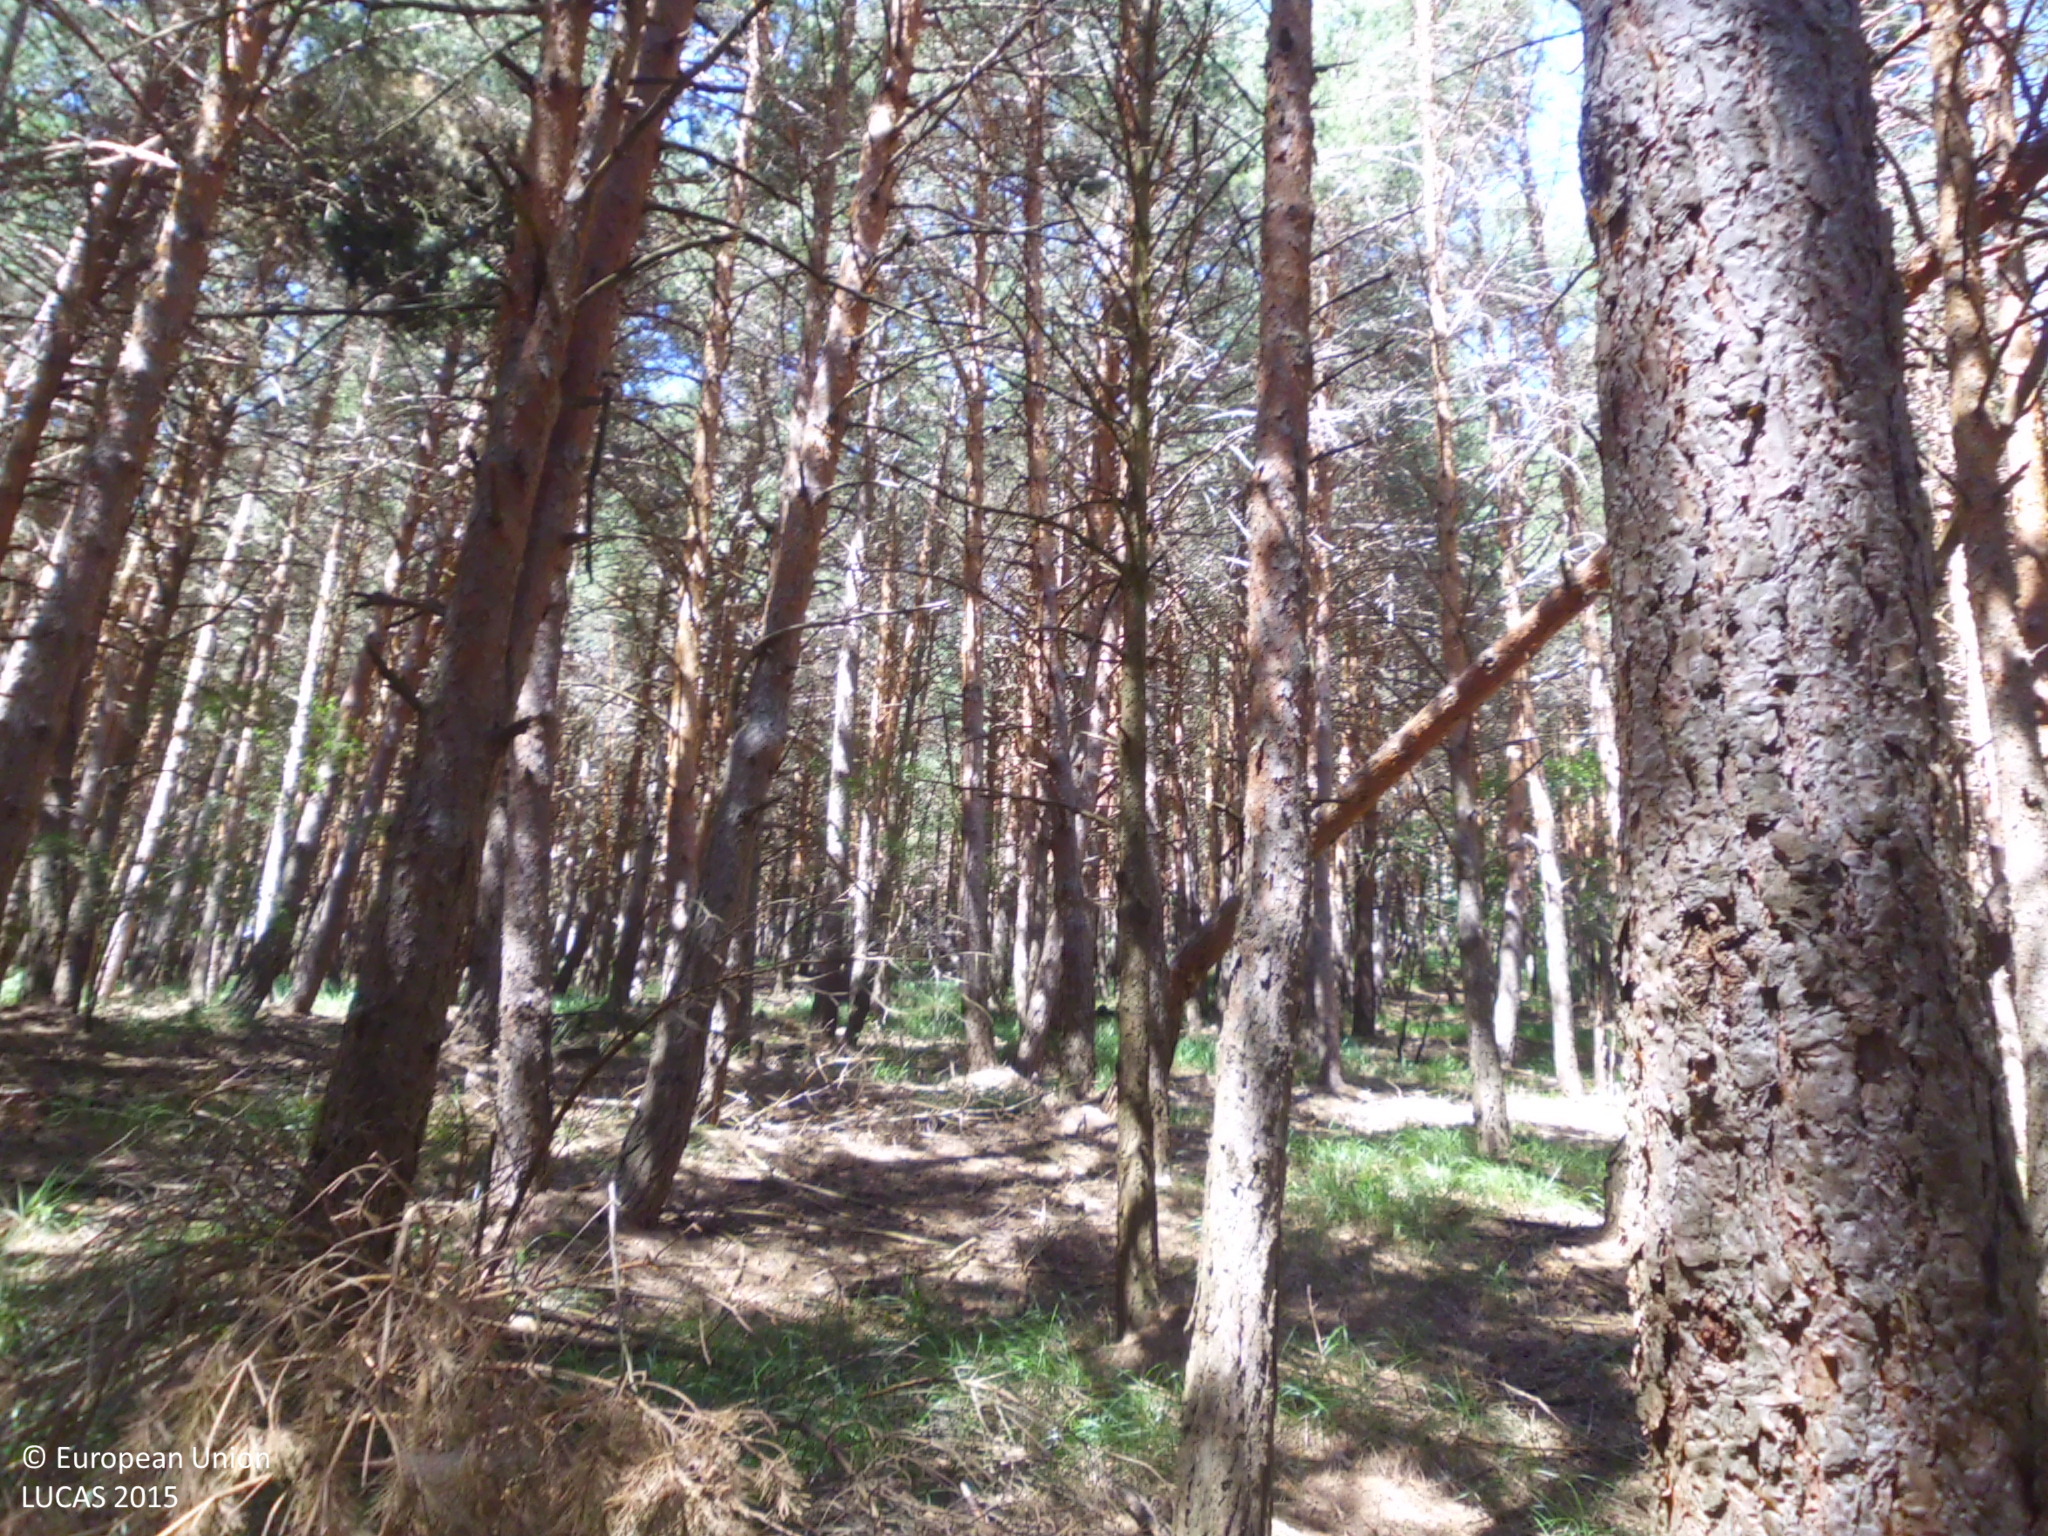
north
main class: Woodland
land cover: Pine dominated coniferous woodland
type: coniferous forest of the mediterranean region
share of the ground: > 75 %
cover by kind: coniferous forest trees 100 %
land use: Forestry
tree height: > 5 m
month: July
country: ES
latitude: 42.8328
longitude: -4.1043
